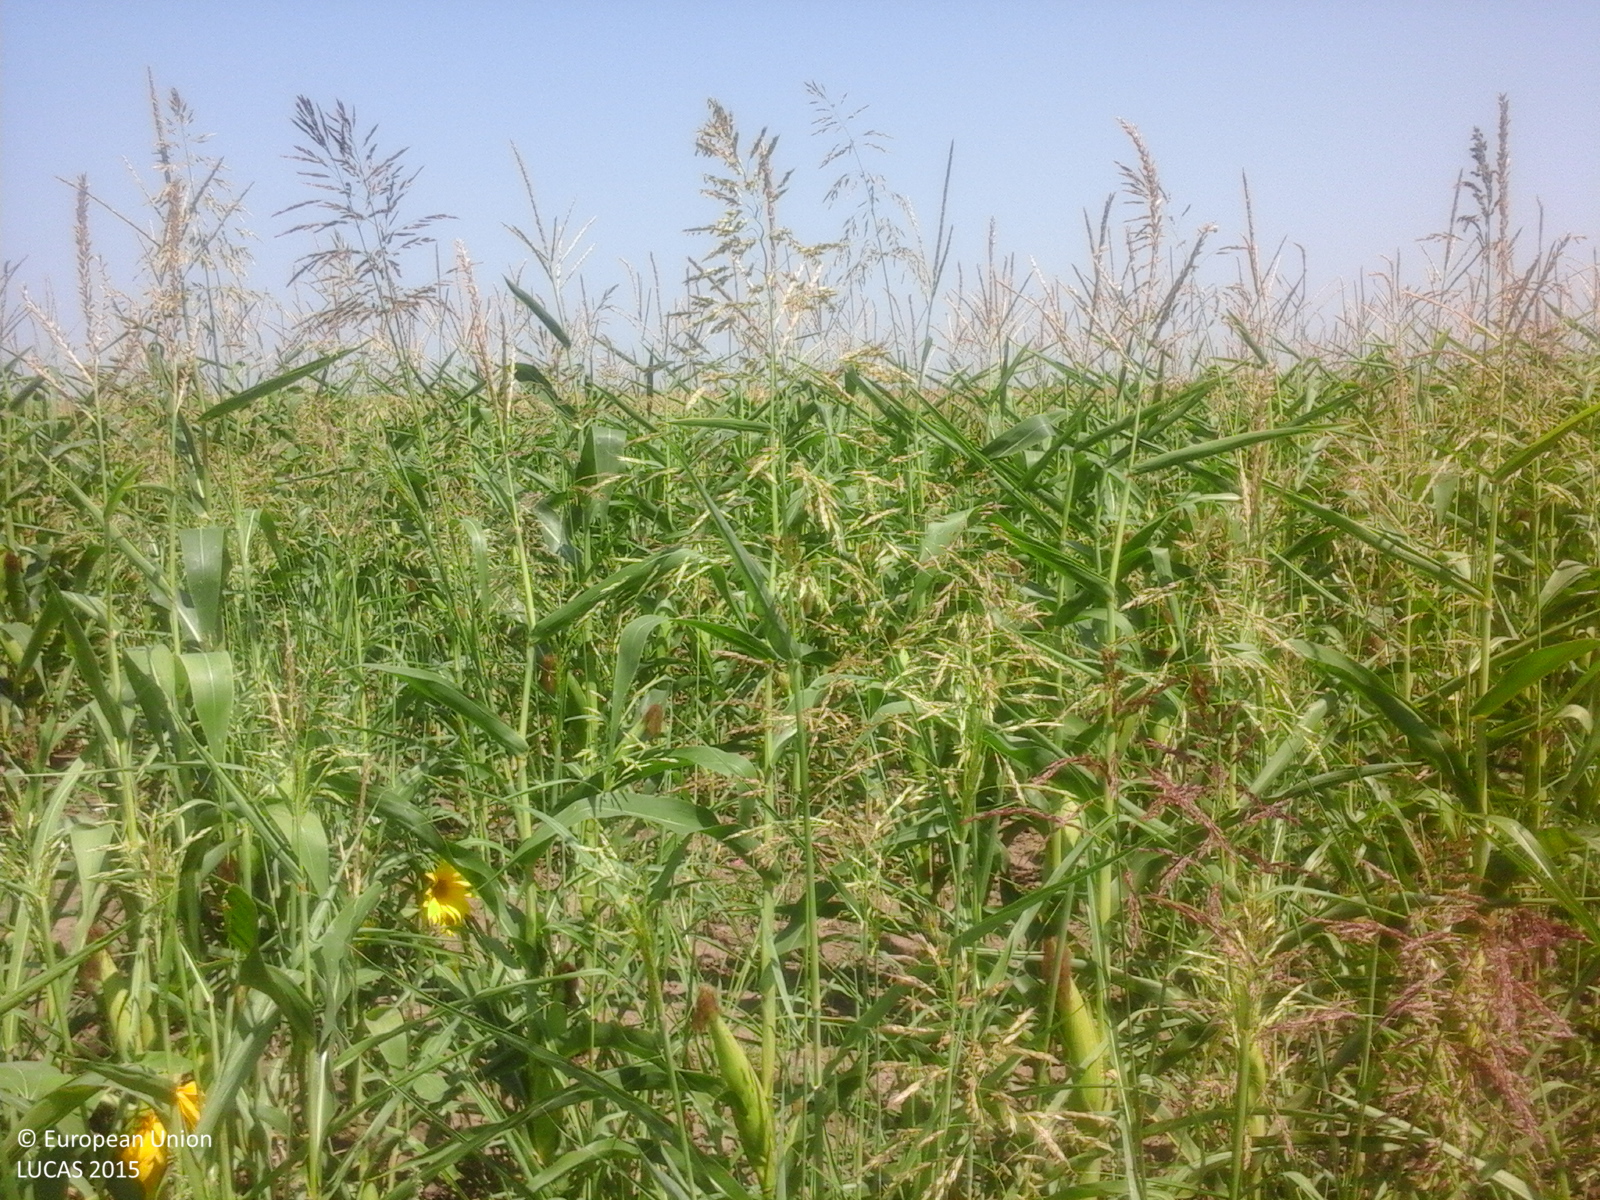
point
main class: Cropland
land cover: Maize
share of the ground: > 75 %
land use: Agriculture (excluding fallow land and kitchen gardens)
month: July
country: RO
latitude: 44.4665
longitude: 26.7517
